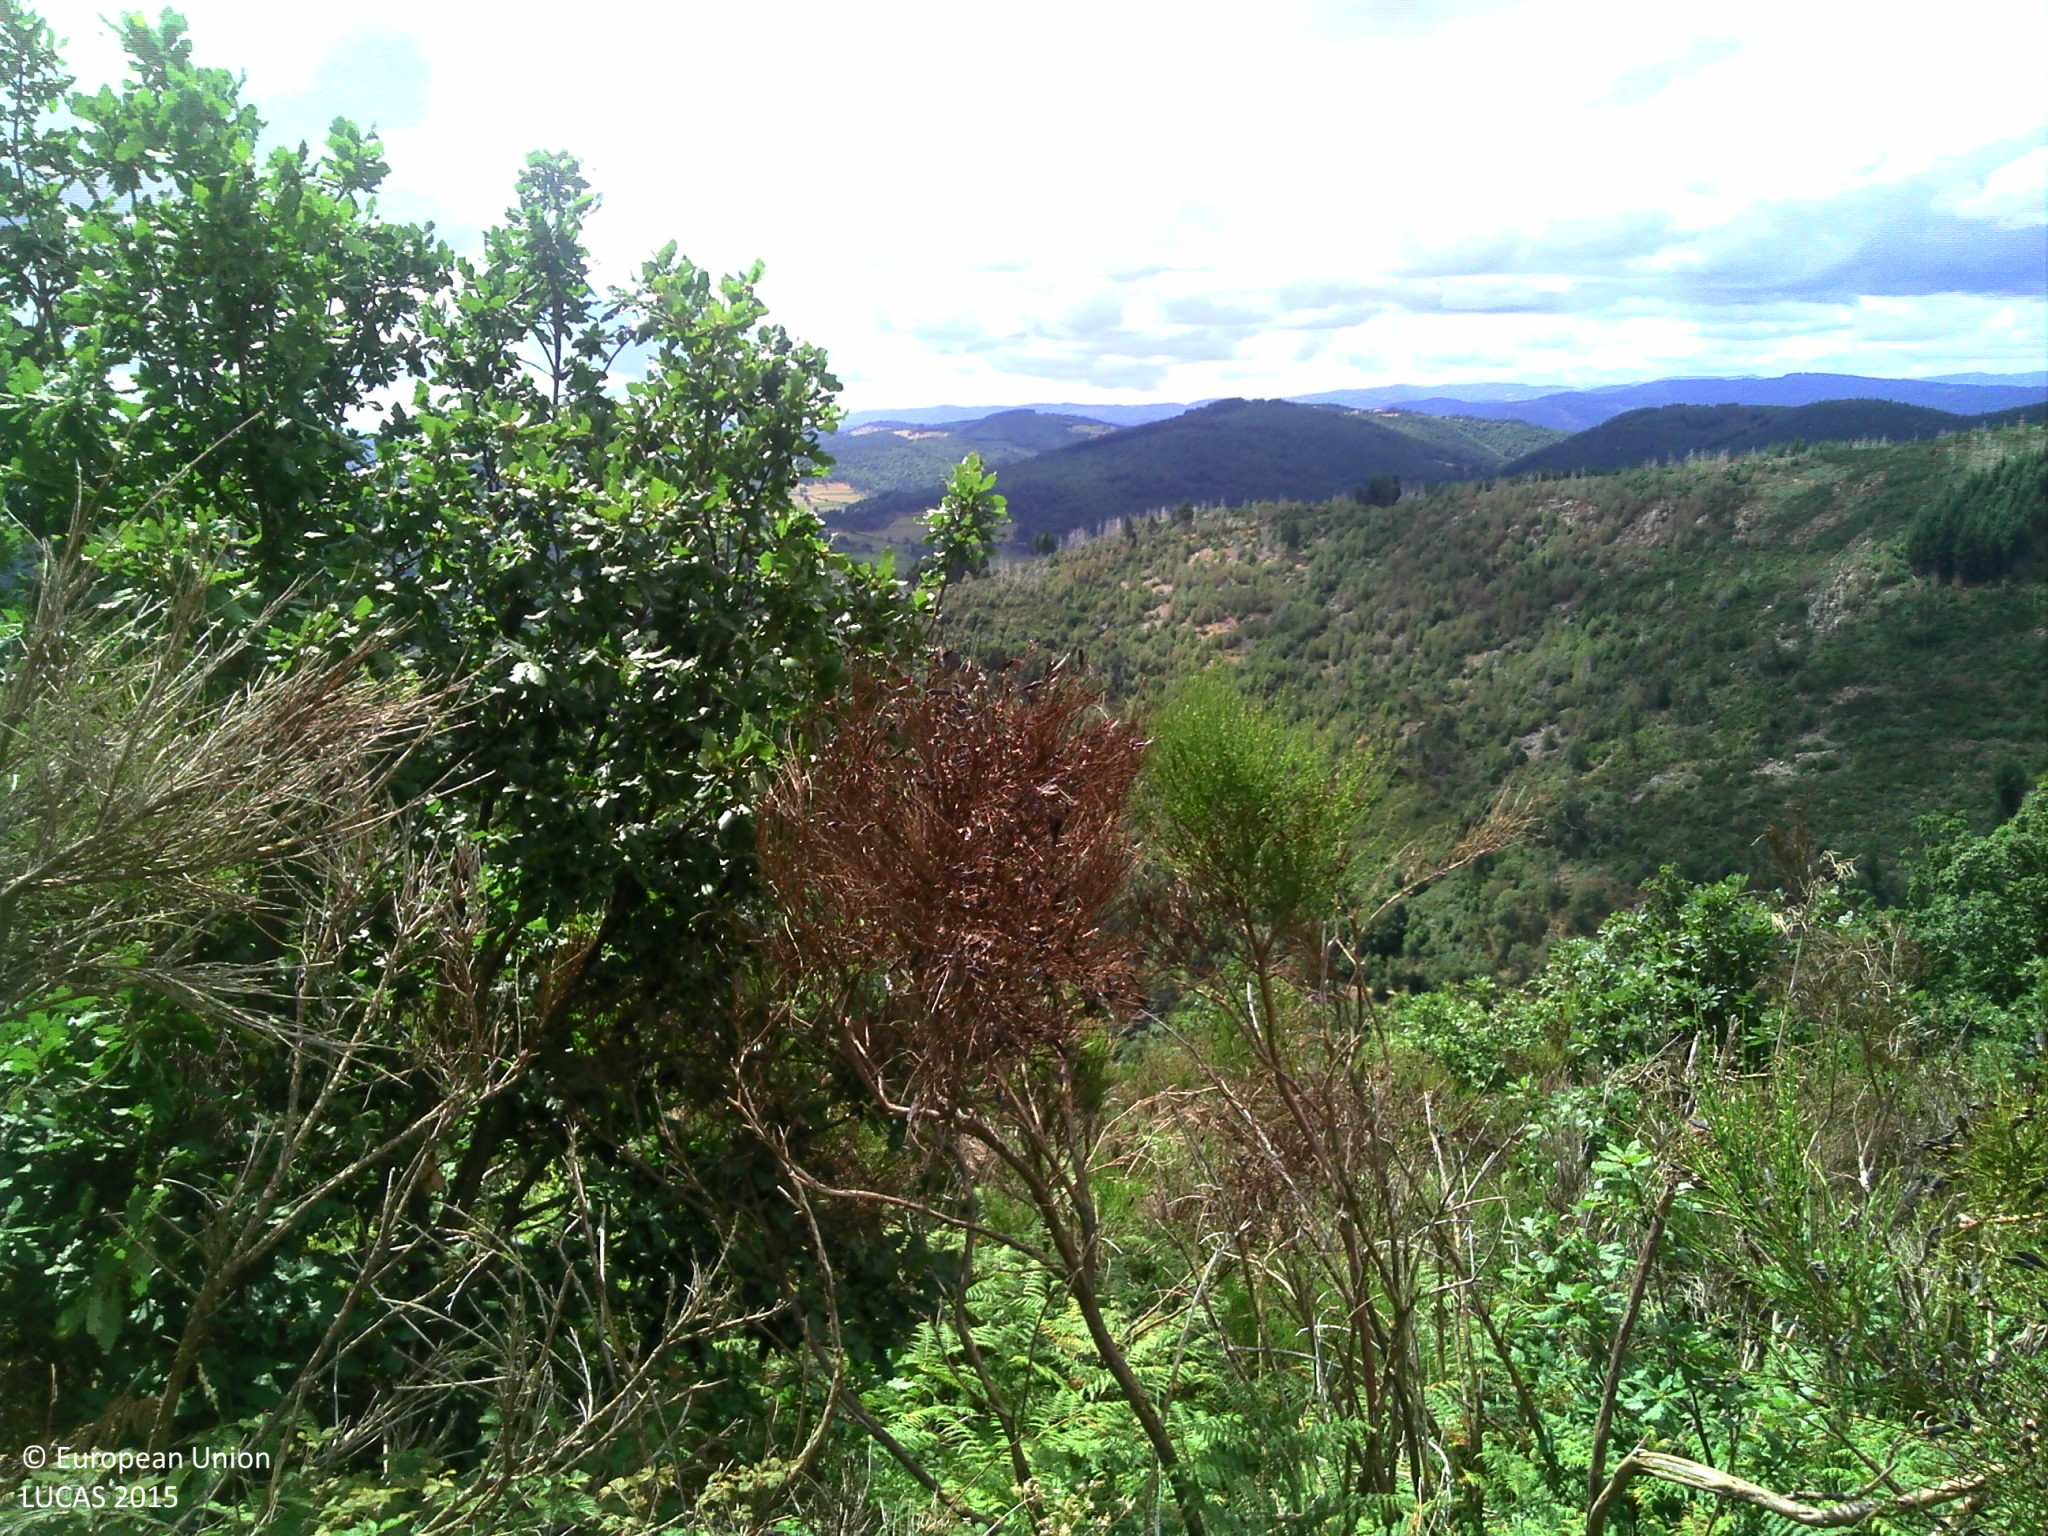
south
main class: Shrubland
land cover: Shrubland with sparse tree cover
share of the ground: > 75 %
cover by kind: shrubs 95 %, broadleaved forest trees 5 %
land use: Semi-natural and natural areas not in use
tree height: < 5 m
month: August
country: FR
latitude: 45.0929
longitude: 4.5539
